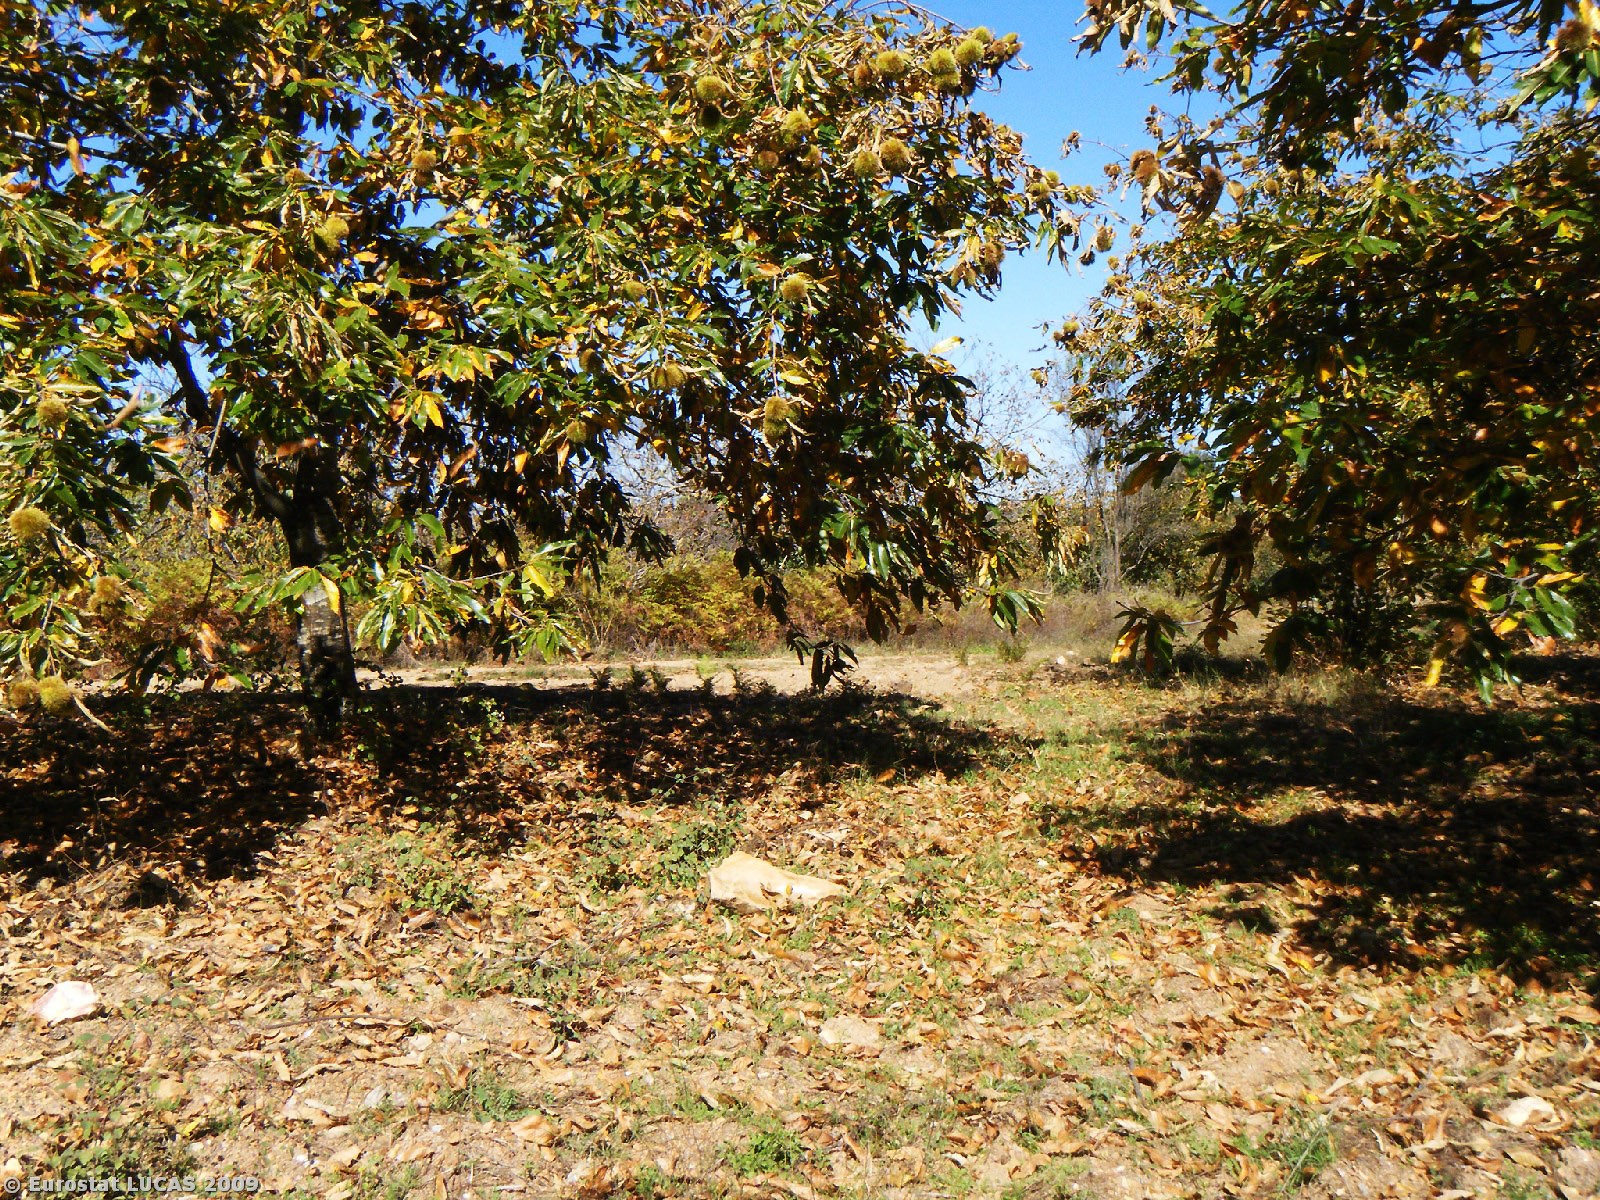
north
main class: Cropland
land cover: Nuts trees
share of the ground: 25 - 50 %
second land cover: Grassland with sparse tree/shrub cover
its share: > 75 %
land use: Agriculture (excluding fallow land and kitchen gardens)
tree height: > 5 m
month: October
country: GR
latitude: 37.3405
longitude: 22.3644
